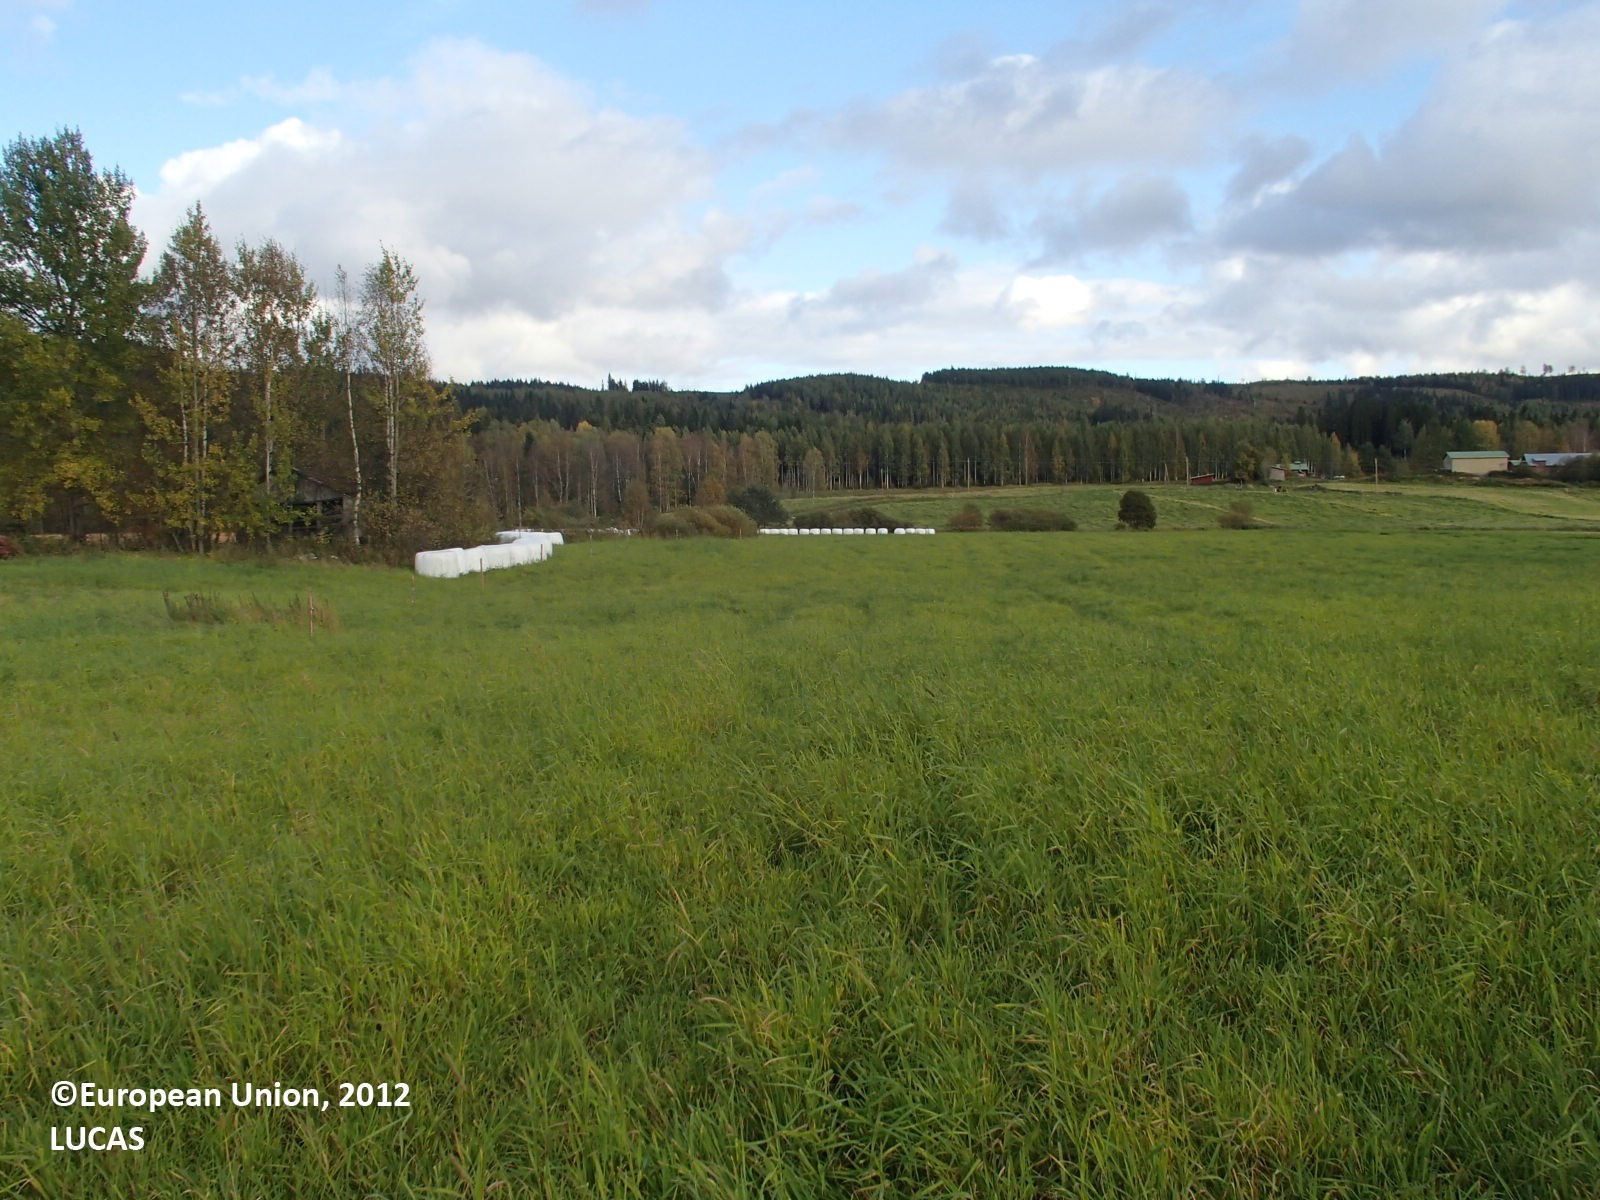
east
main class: Cropland
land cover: Temporary grasslands
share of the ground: > 75 %
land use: Agriculture (excluding fallow land and kitchen gardens)
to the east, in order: Temporary grasslands; Artificial constructions in urban areas; Ditches and canals; Grass margins; Paved roads, cycling and walking lanes; Grass margins; Ditches and canals; Temporary grasslands; Spontaneously vegetated surfaces; Ditches and canals
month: September
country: FI
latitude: 63.3047
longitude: 27.9498
